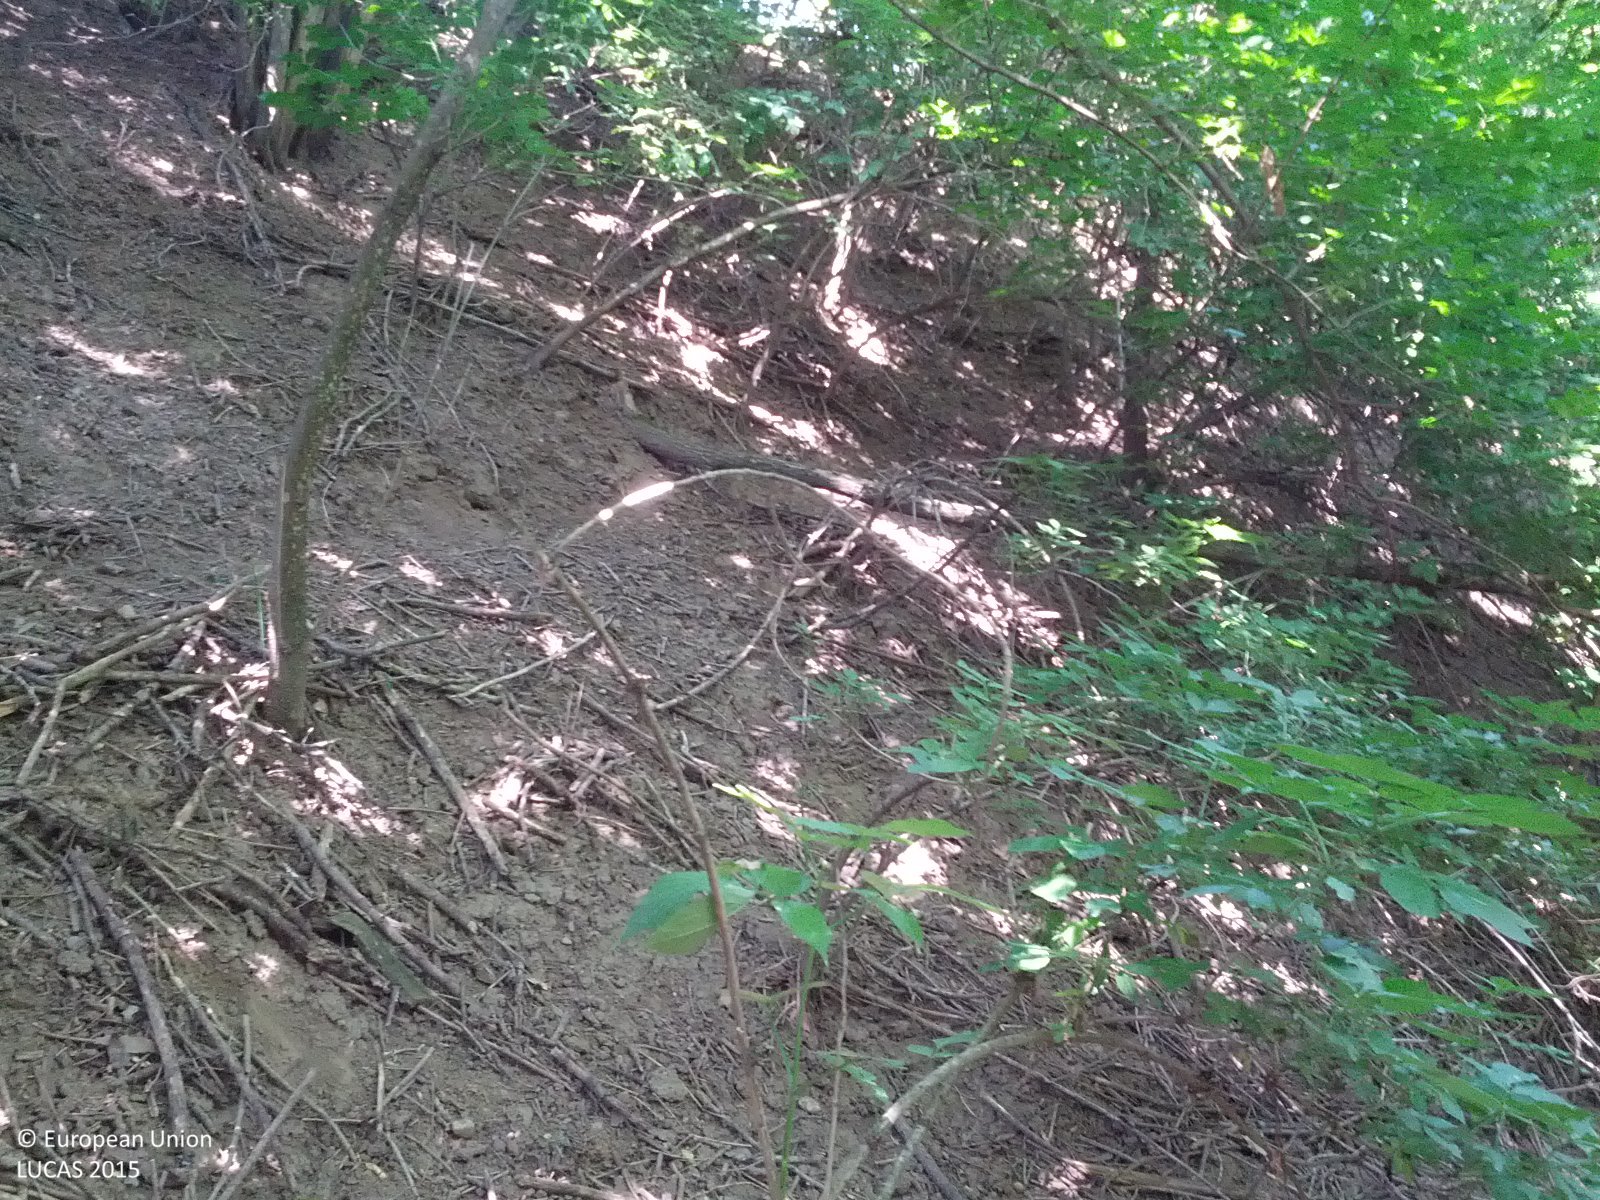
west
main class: Woodland
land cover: Broadleaved woodland
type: acidophilous oak and oak-birch forest
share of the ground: > 75 %
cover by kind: broadleaved forest trees 90 %, unconsolidated bare surface 10 %
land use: Forestry
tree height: > 5 m
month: July
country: AT
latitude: 48.5359
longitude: 16.8197
